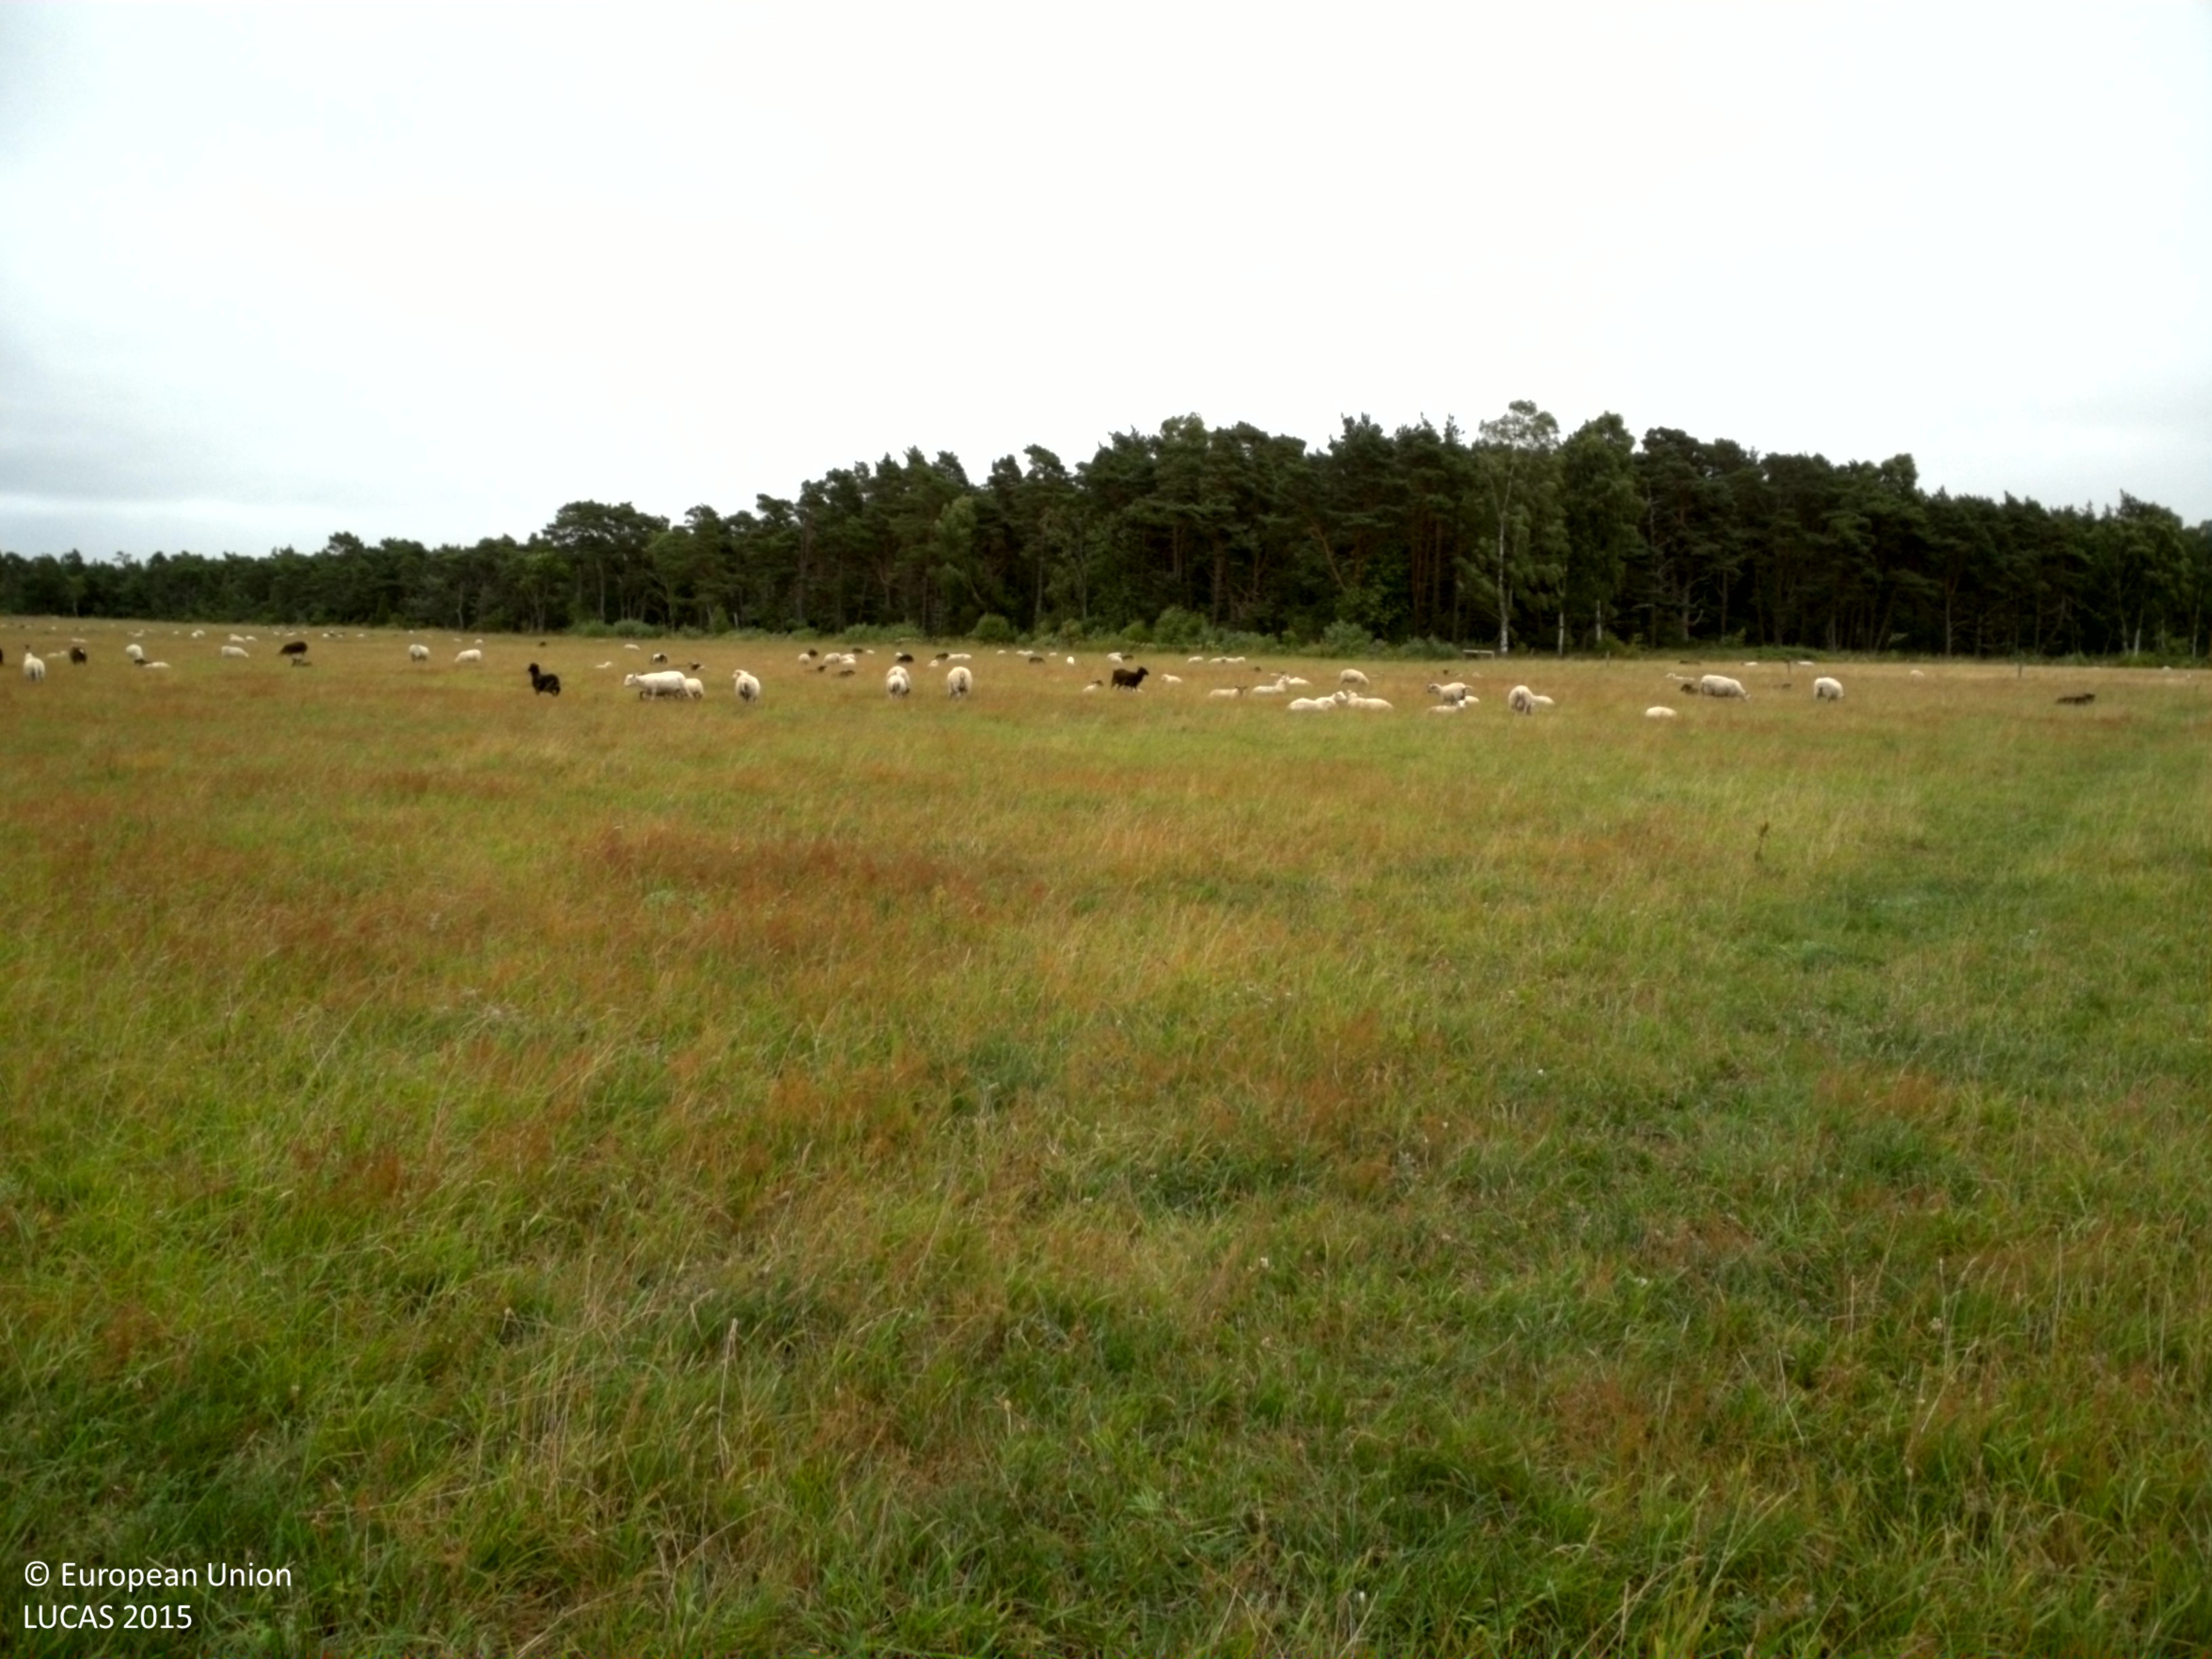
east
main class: Grassland
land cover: Grassland without tree/shrub cover
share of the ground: > 75 %
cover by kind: herbaceous plants 100 %
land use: Agriculture (excluding fallow land and kitchen gardens)
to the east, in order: Grassland without tree/shrub cover; Fences; Abandoned hedges; Ditches and canals; Pine dominated coniferous woodland
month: July
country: SE
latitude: 57.4470
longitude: 18.1549
